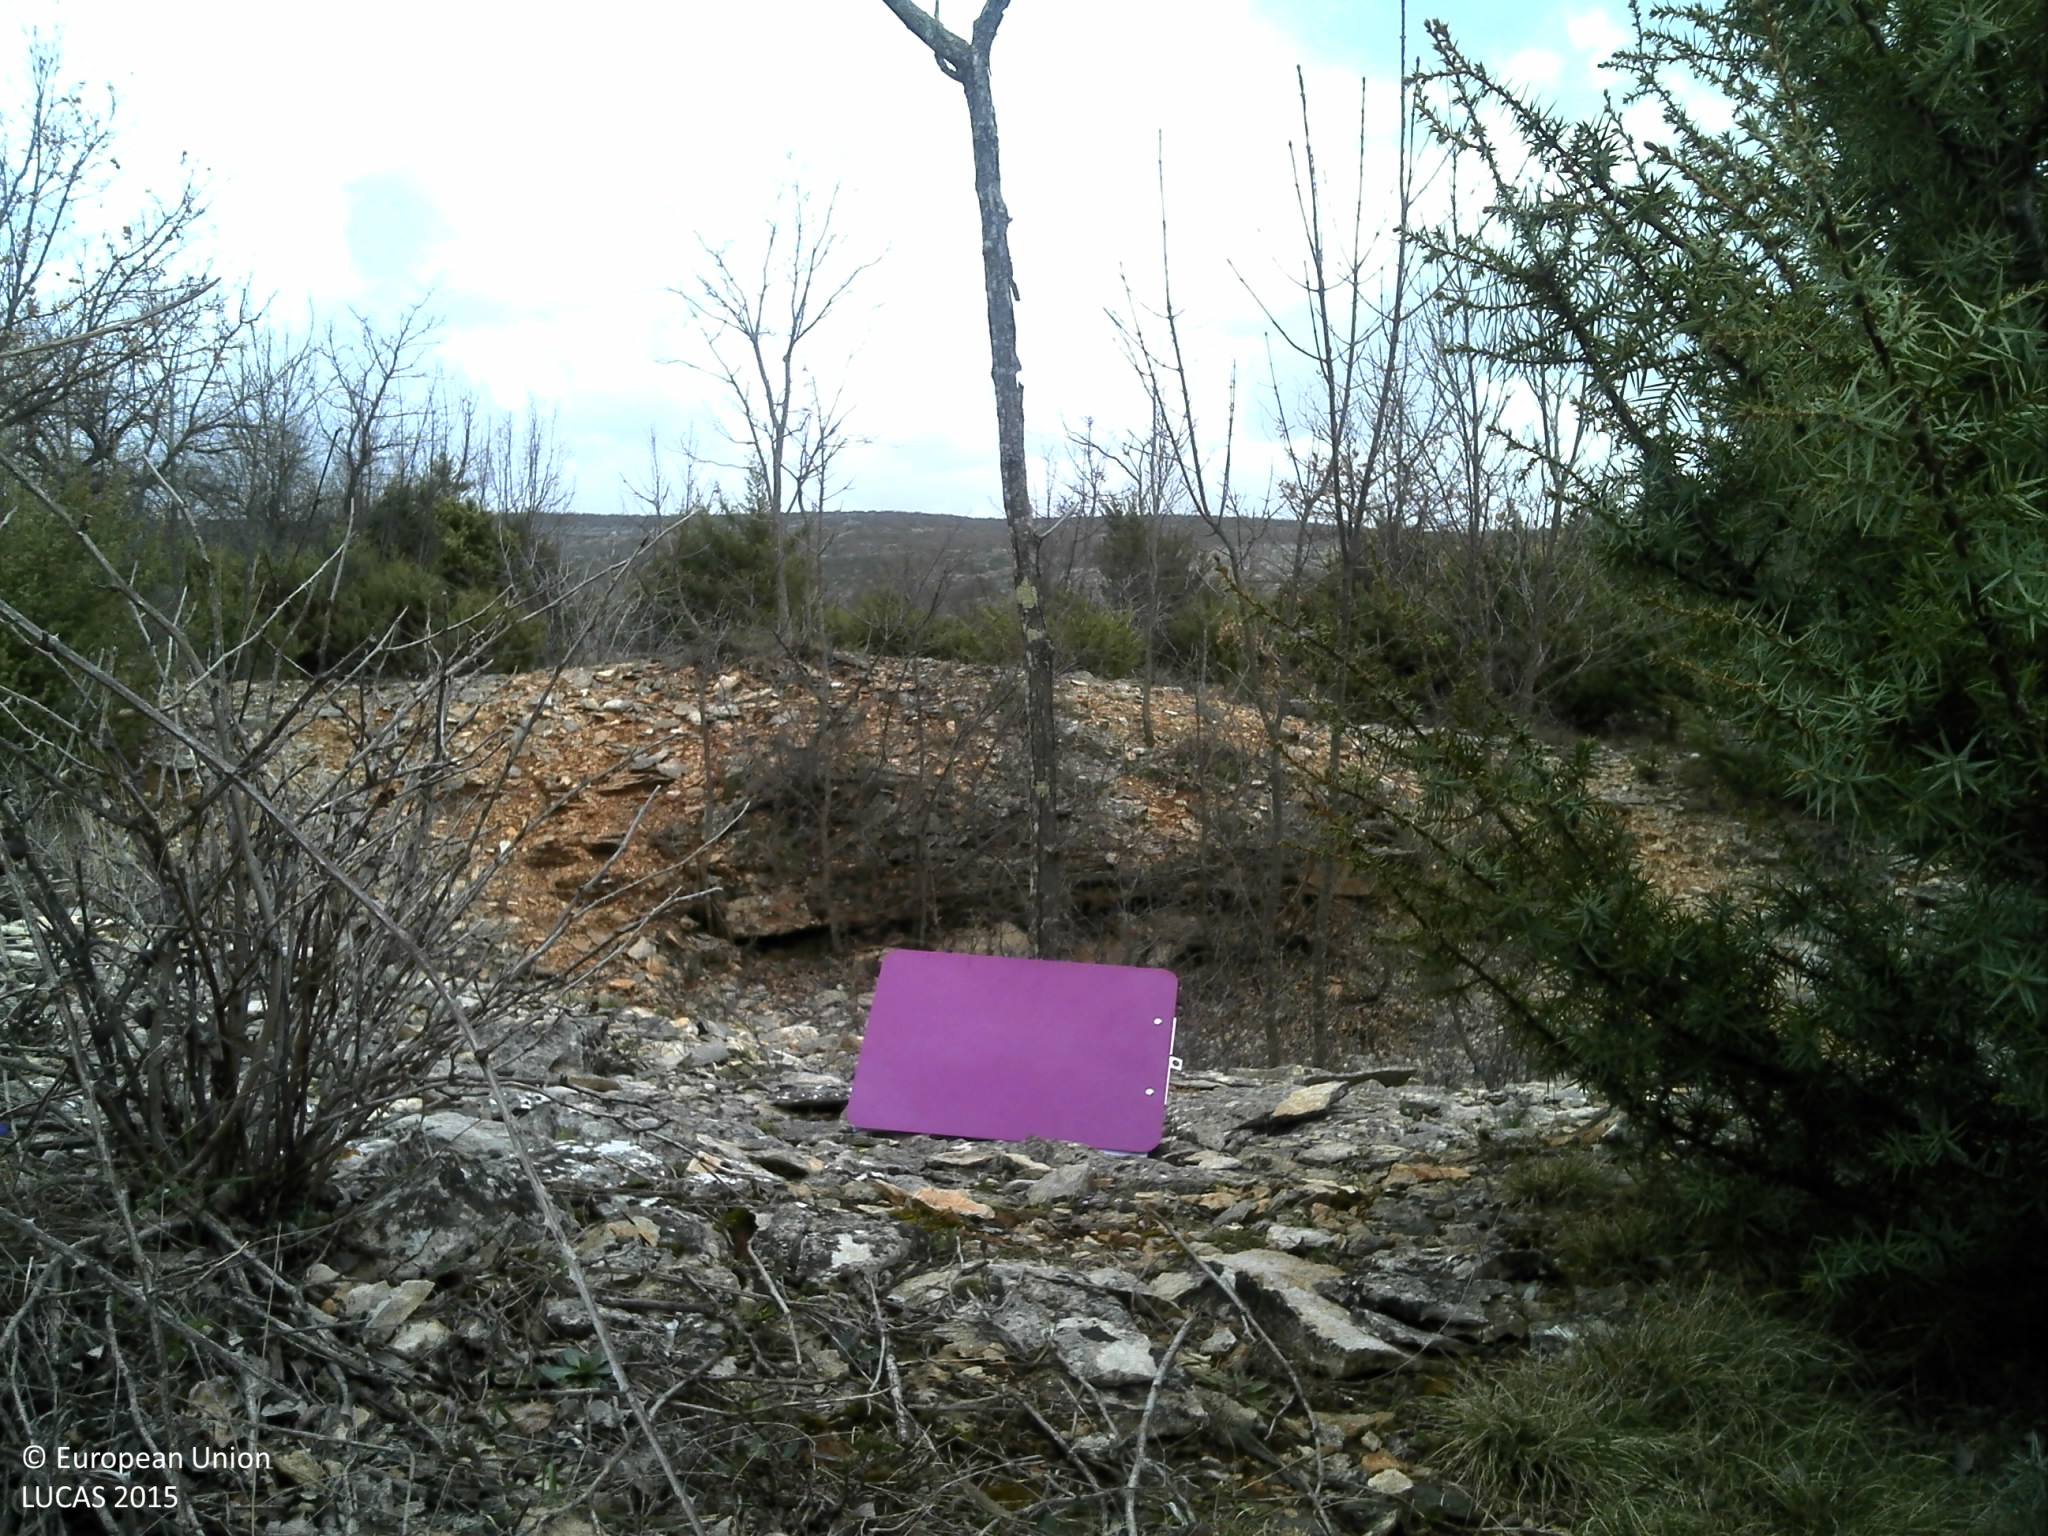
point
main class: Woodland
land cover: Broadleaved woodland
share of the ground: 25 - 50 %
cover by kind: unconsolidated bare surface 35 %, broadleaved forest trees 25 %, shrubs 25 %, herbaceous plants 15 %
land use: Semi-natural and natural areas not in use
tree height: < 5 m
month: March
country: HR
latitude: 43.9872
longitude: 15.8395
